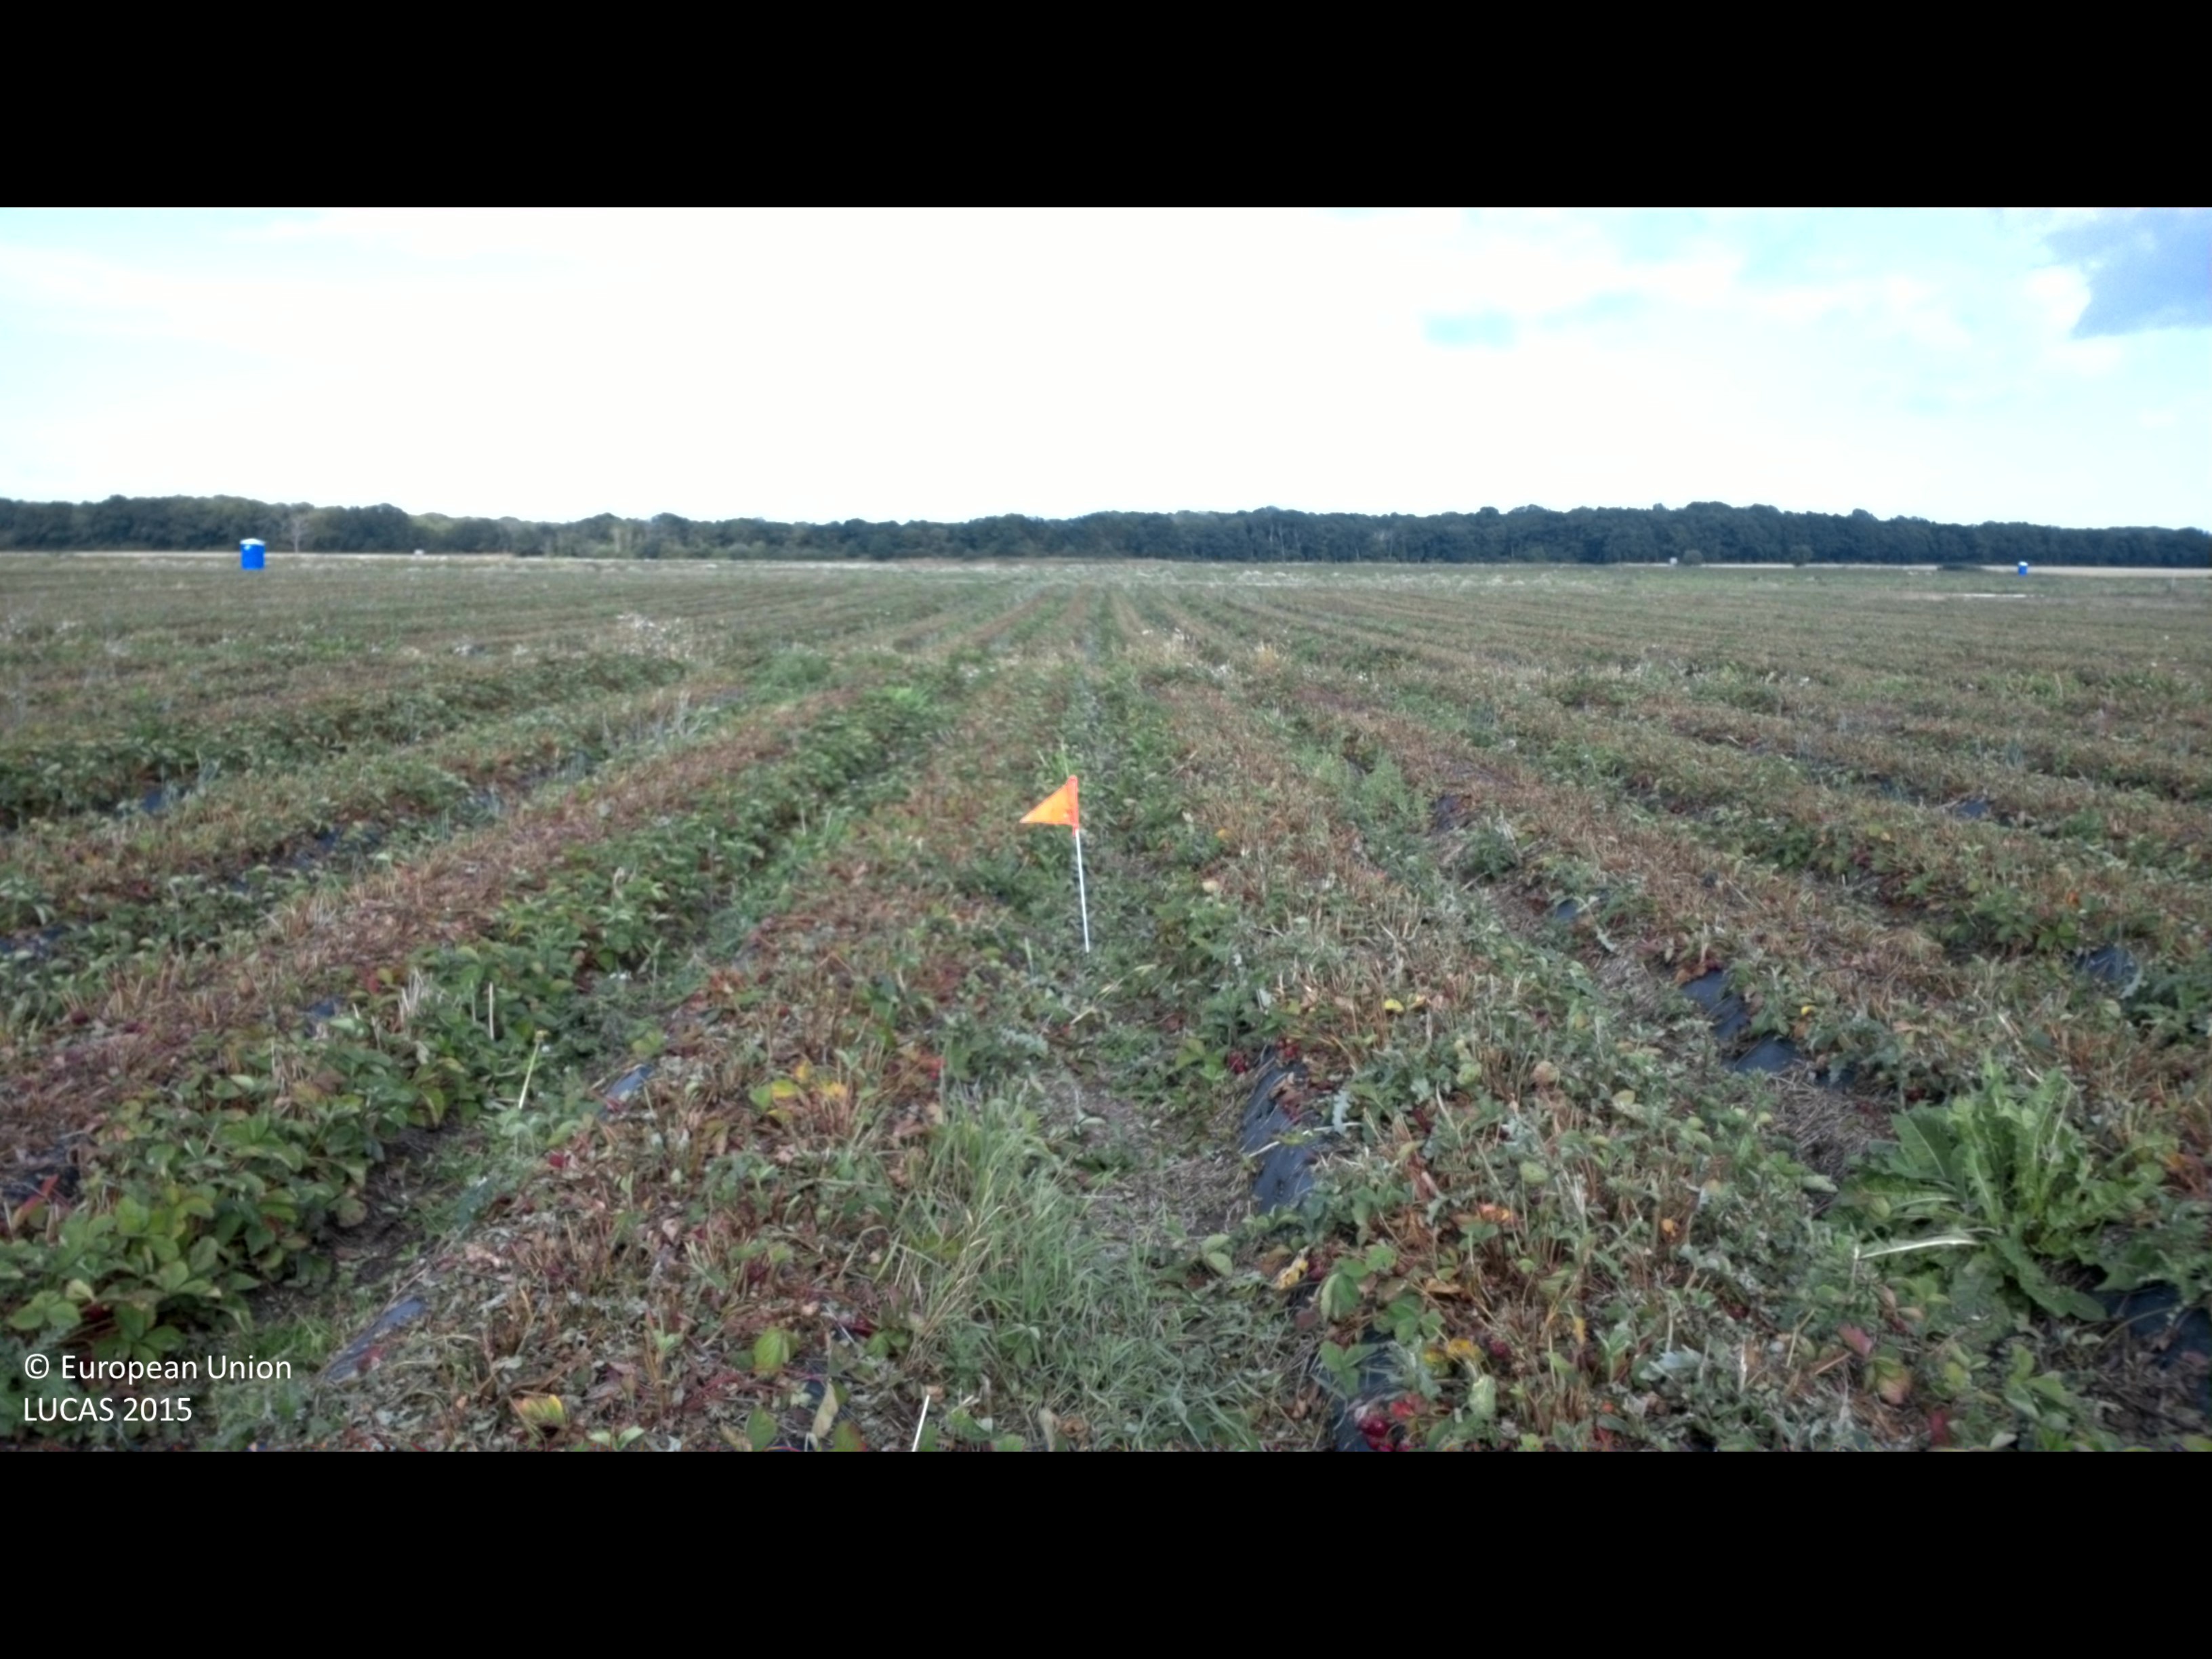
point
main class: Cropland
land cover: Strawberries
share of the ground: > 75 %
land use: Agriculture (excluding fallow land and kitchen gardens)
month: July
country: SE
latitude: 56.5678
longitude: 16.4298
